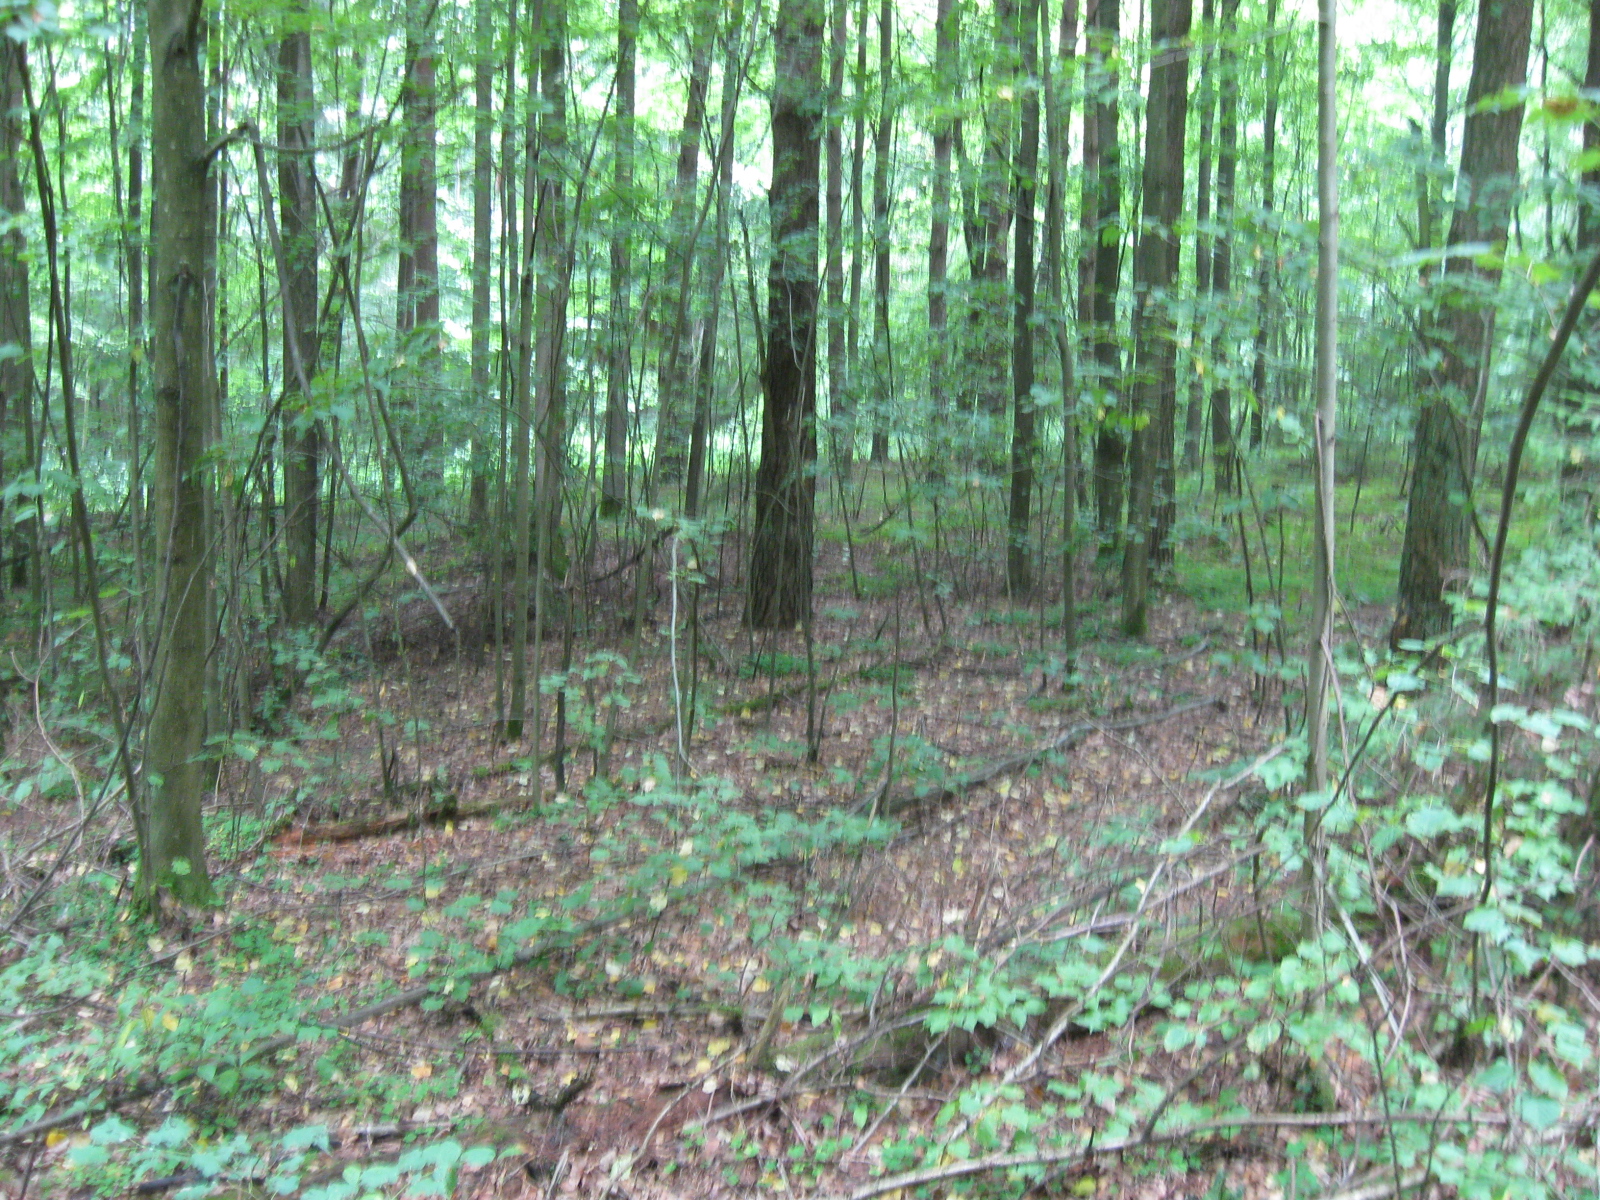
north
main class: Woodland
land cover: Pine dominated mixed woodland
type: hemiboreal forest and nemoral coniferous forest and mixed broadleaved-coniferous forest
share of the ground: > 75 %
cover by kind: broadleaved forest trees 45 %, coniferous forest trees 40 %, unconsolidated bare surface 10 %, herbaceous plants 5 %
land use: Forestry
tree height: > 5 m
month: July
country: LT
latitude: 55.0196
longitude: 23.6119
